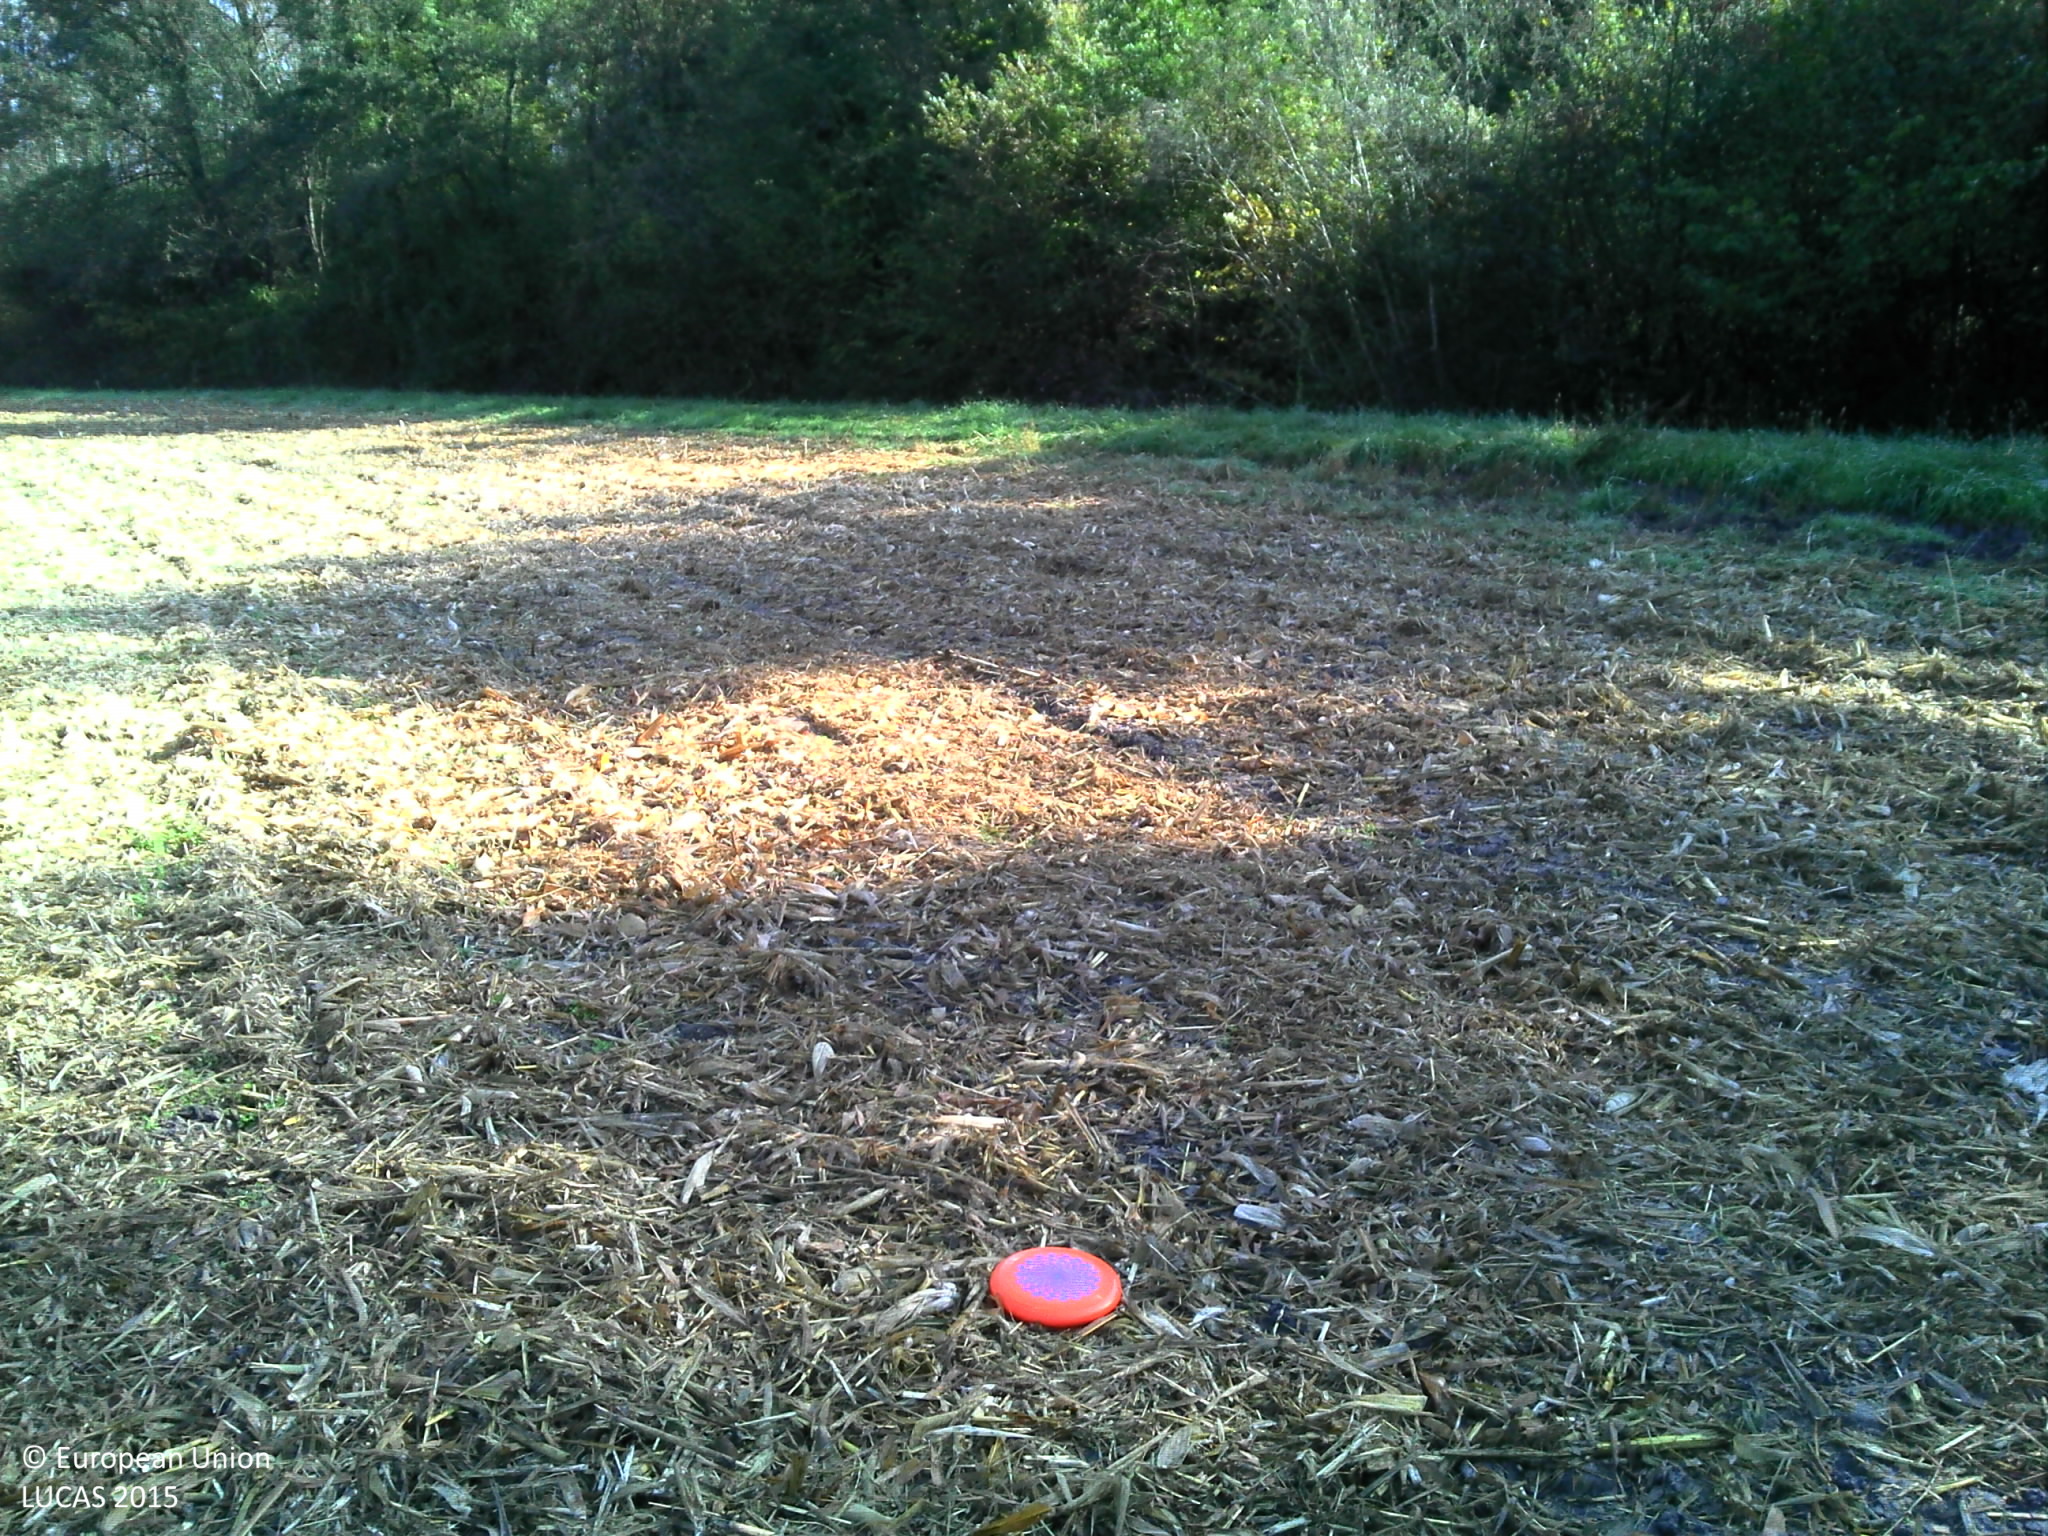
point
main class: Cropland
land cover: Maize
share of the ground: > 75 %
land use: Agriculture (excluding fallow land and kitchen gardens)
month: October
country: FR
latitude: 45.5425
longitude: 6.1496
